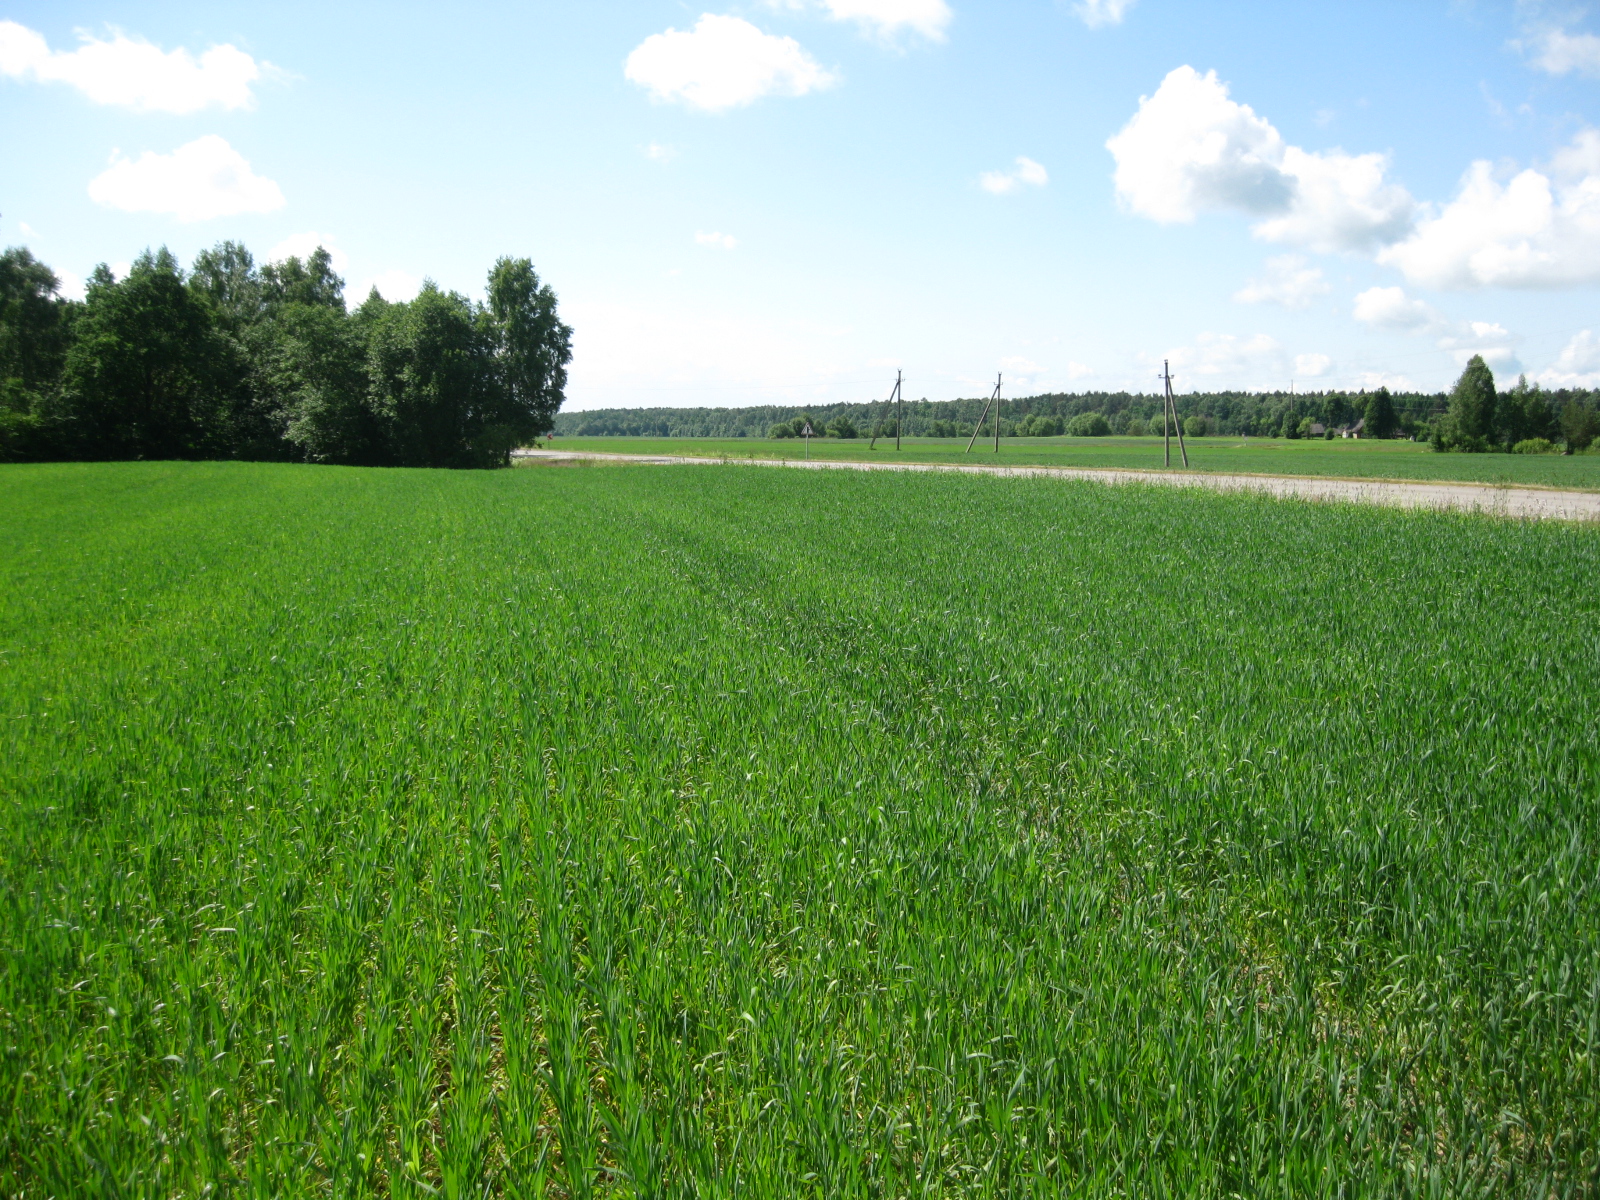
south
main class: Cropland
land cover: Triticale
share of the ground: > 75 %
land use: Agriculture (excluding fallow land and kitchen gardens)
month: June
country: LT
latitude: 55.5303
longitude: 24.1124
